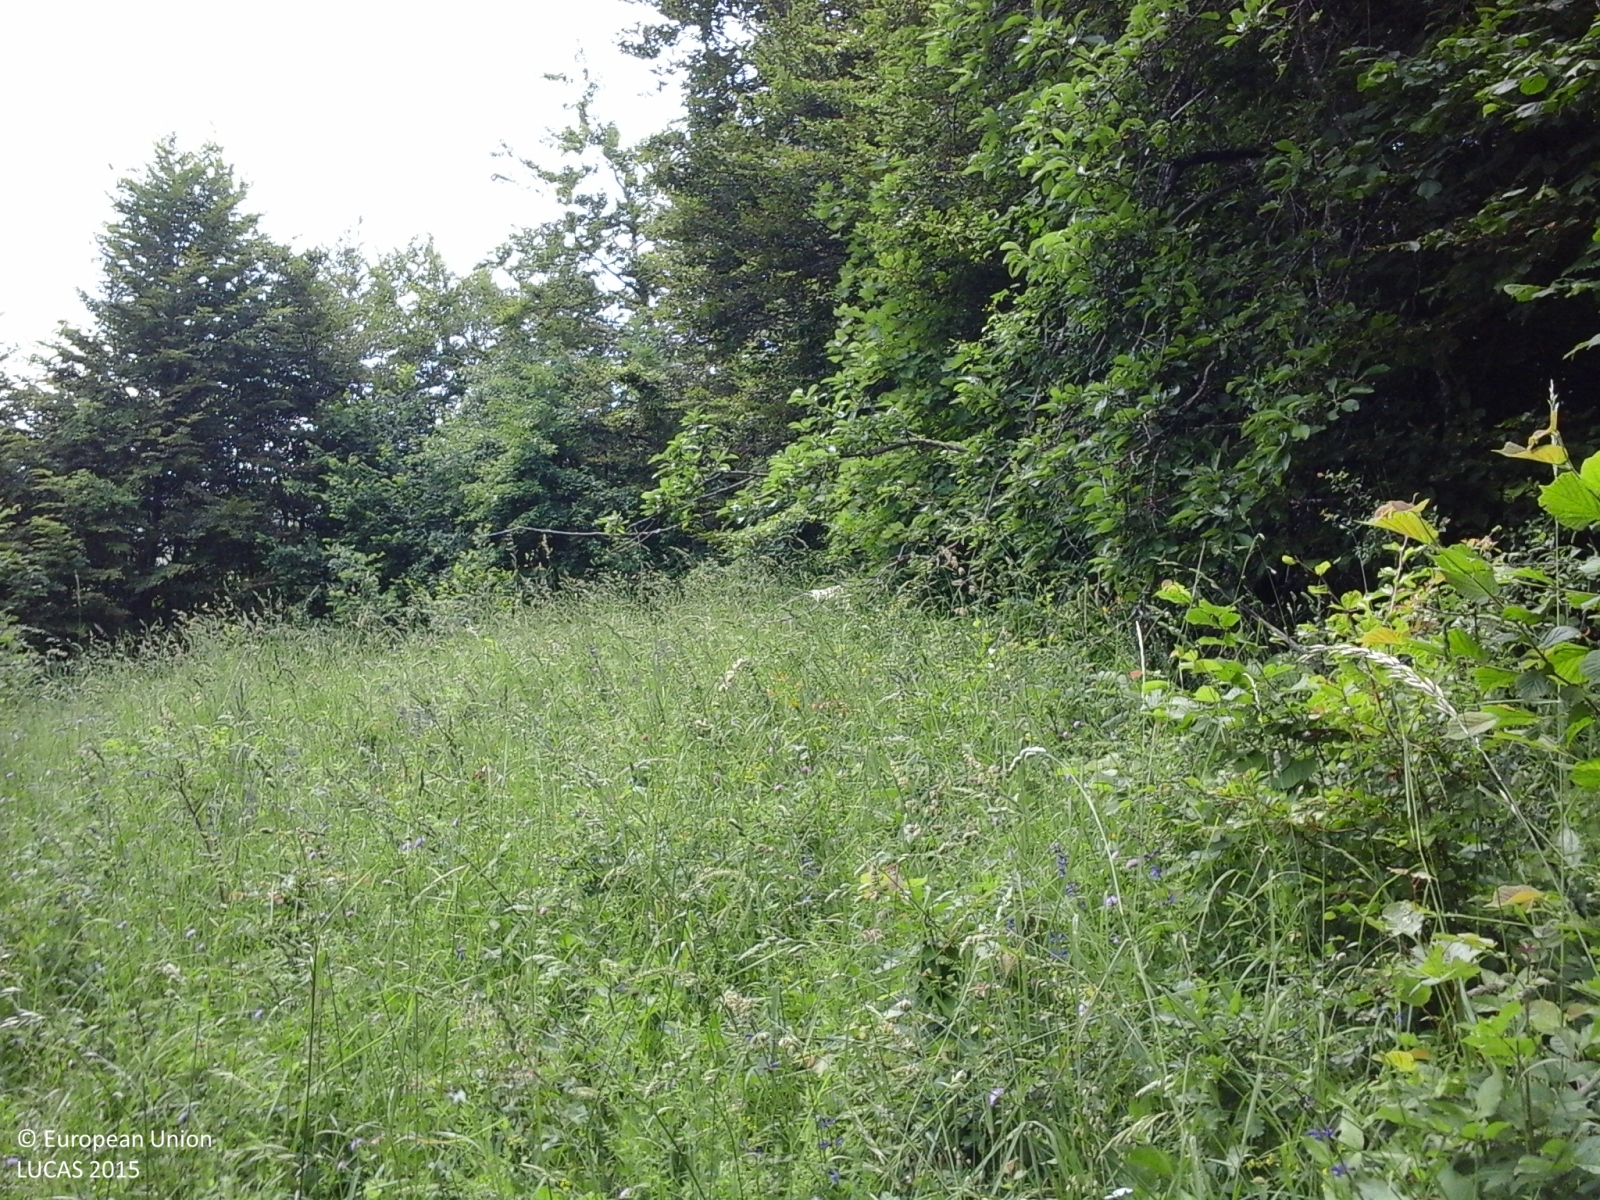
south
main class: Grassland
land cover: Grassland without tree/shrub cover
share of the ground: > 75 %
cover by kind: herbaceous plants 100 %
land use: Forestry
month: June
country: IT
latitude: 44.6927
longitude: 9.6852
